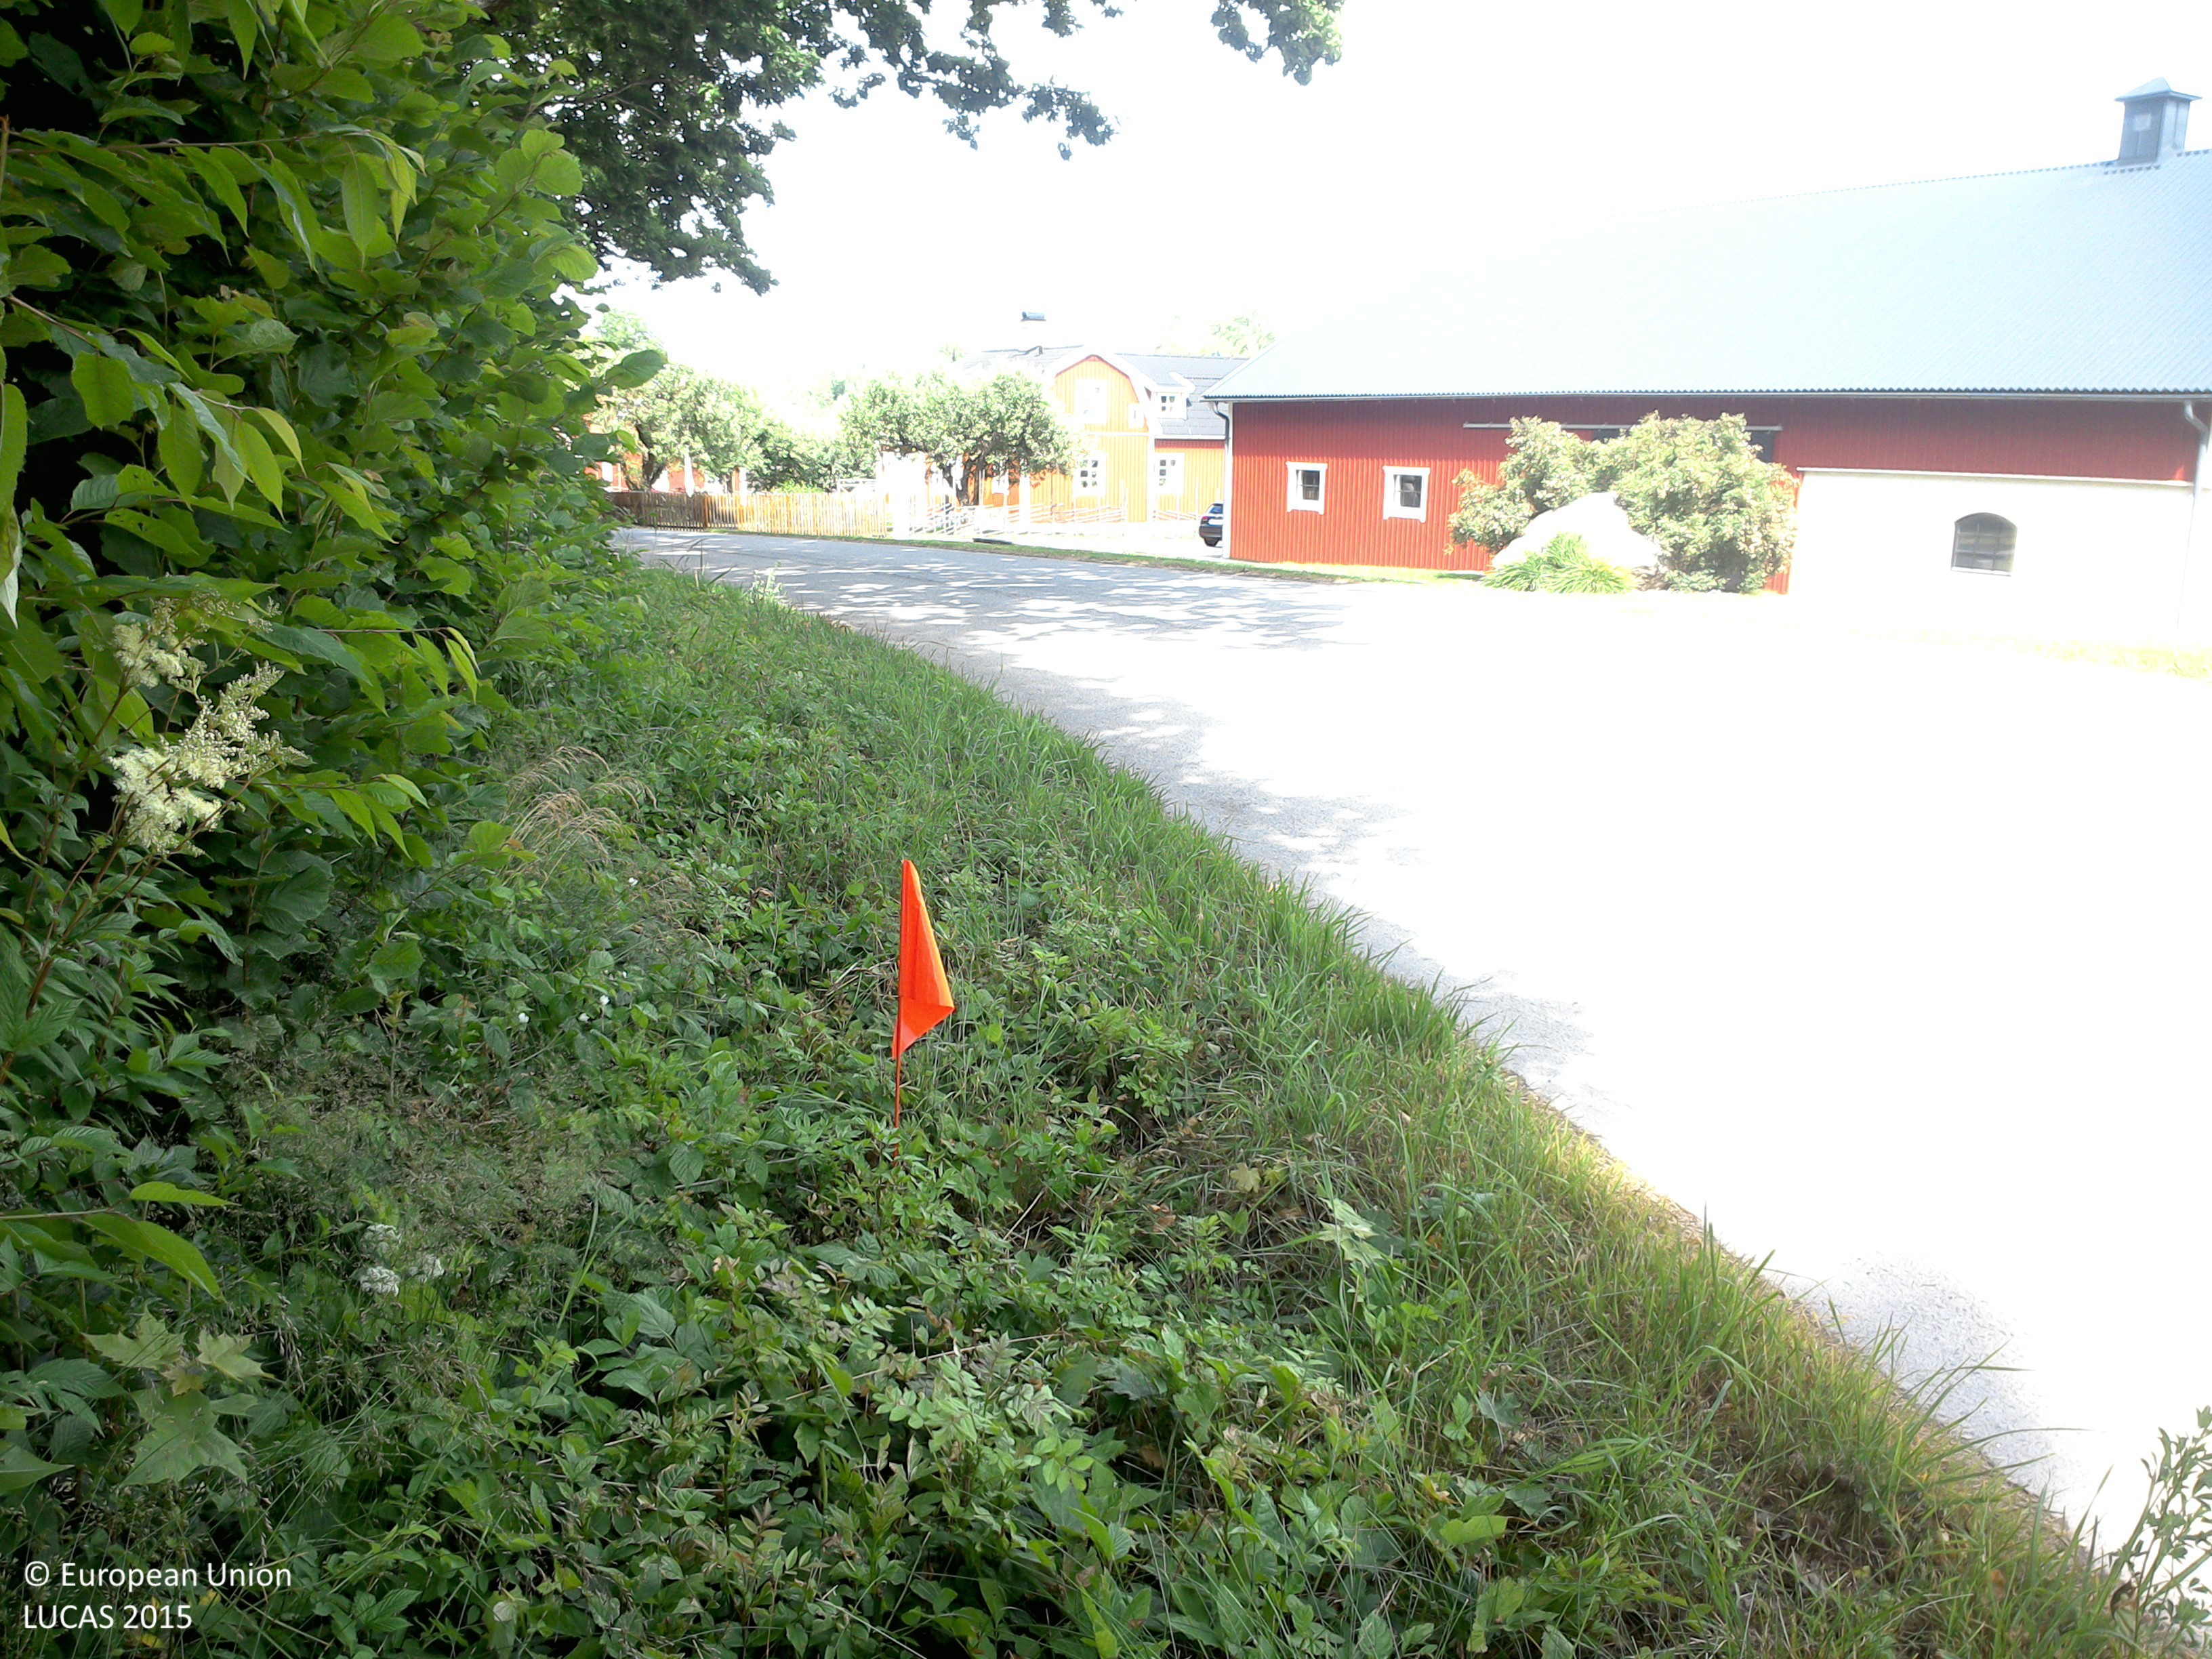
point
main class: Woodland
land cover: Broadleaved woodland
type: boreal forest
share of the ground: > 75 %
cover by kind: broadleaved forest trees 85 %, herbaceous plants 15 %
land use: Forestry
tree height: > 5 m
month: July
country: SE
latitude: 58.5376
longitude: 15.0954
